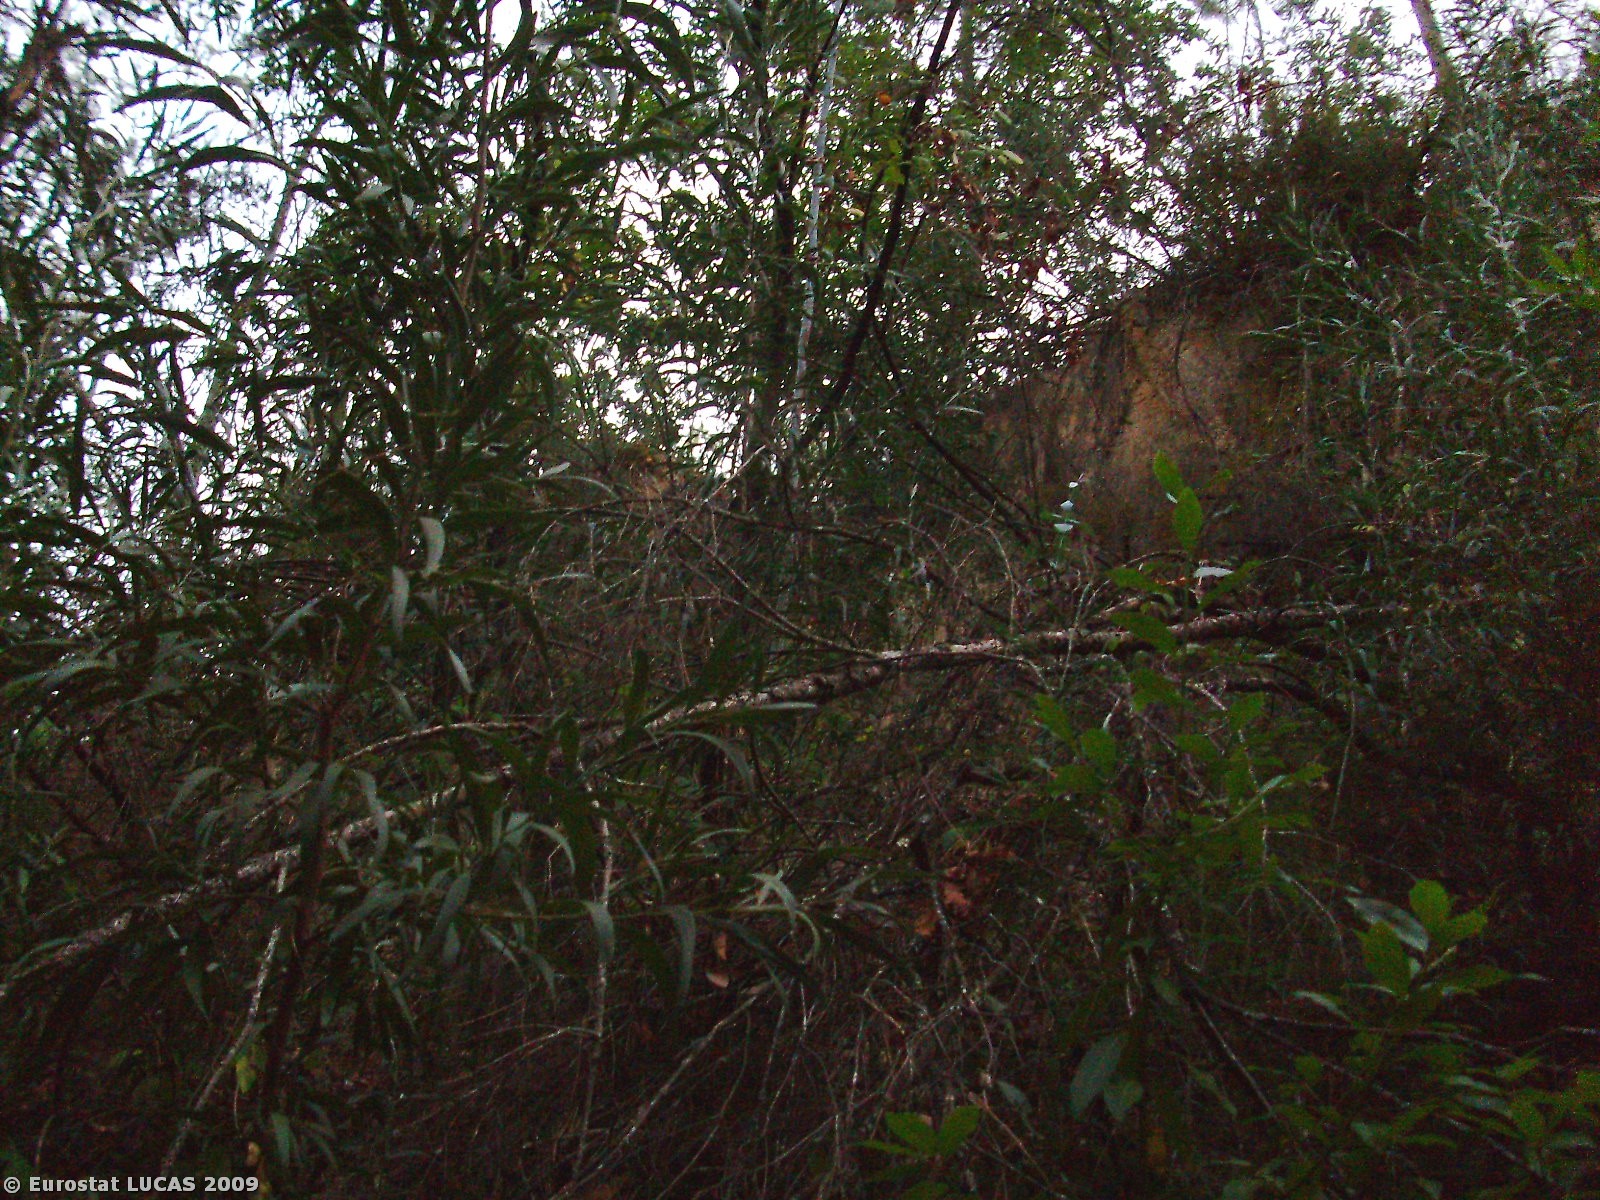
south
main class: Woodland
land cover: Broadleaved woodland
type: thermophilous deciduous forest
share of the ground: 25 - 50 %
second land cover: Shrubland with sparse tree cover
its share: 50 - 75 %
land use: Forestry
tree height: > 5 m
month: August
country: PT
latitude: 40.0583
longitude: -8.3313
